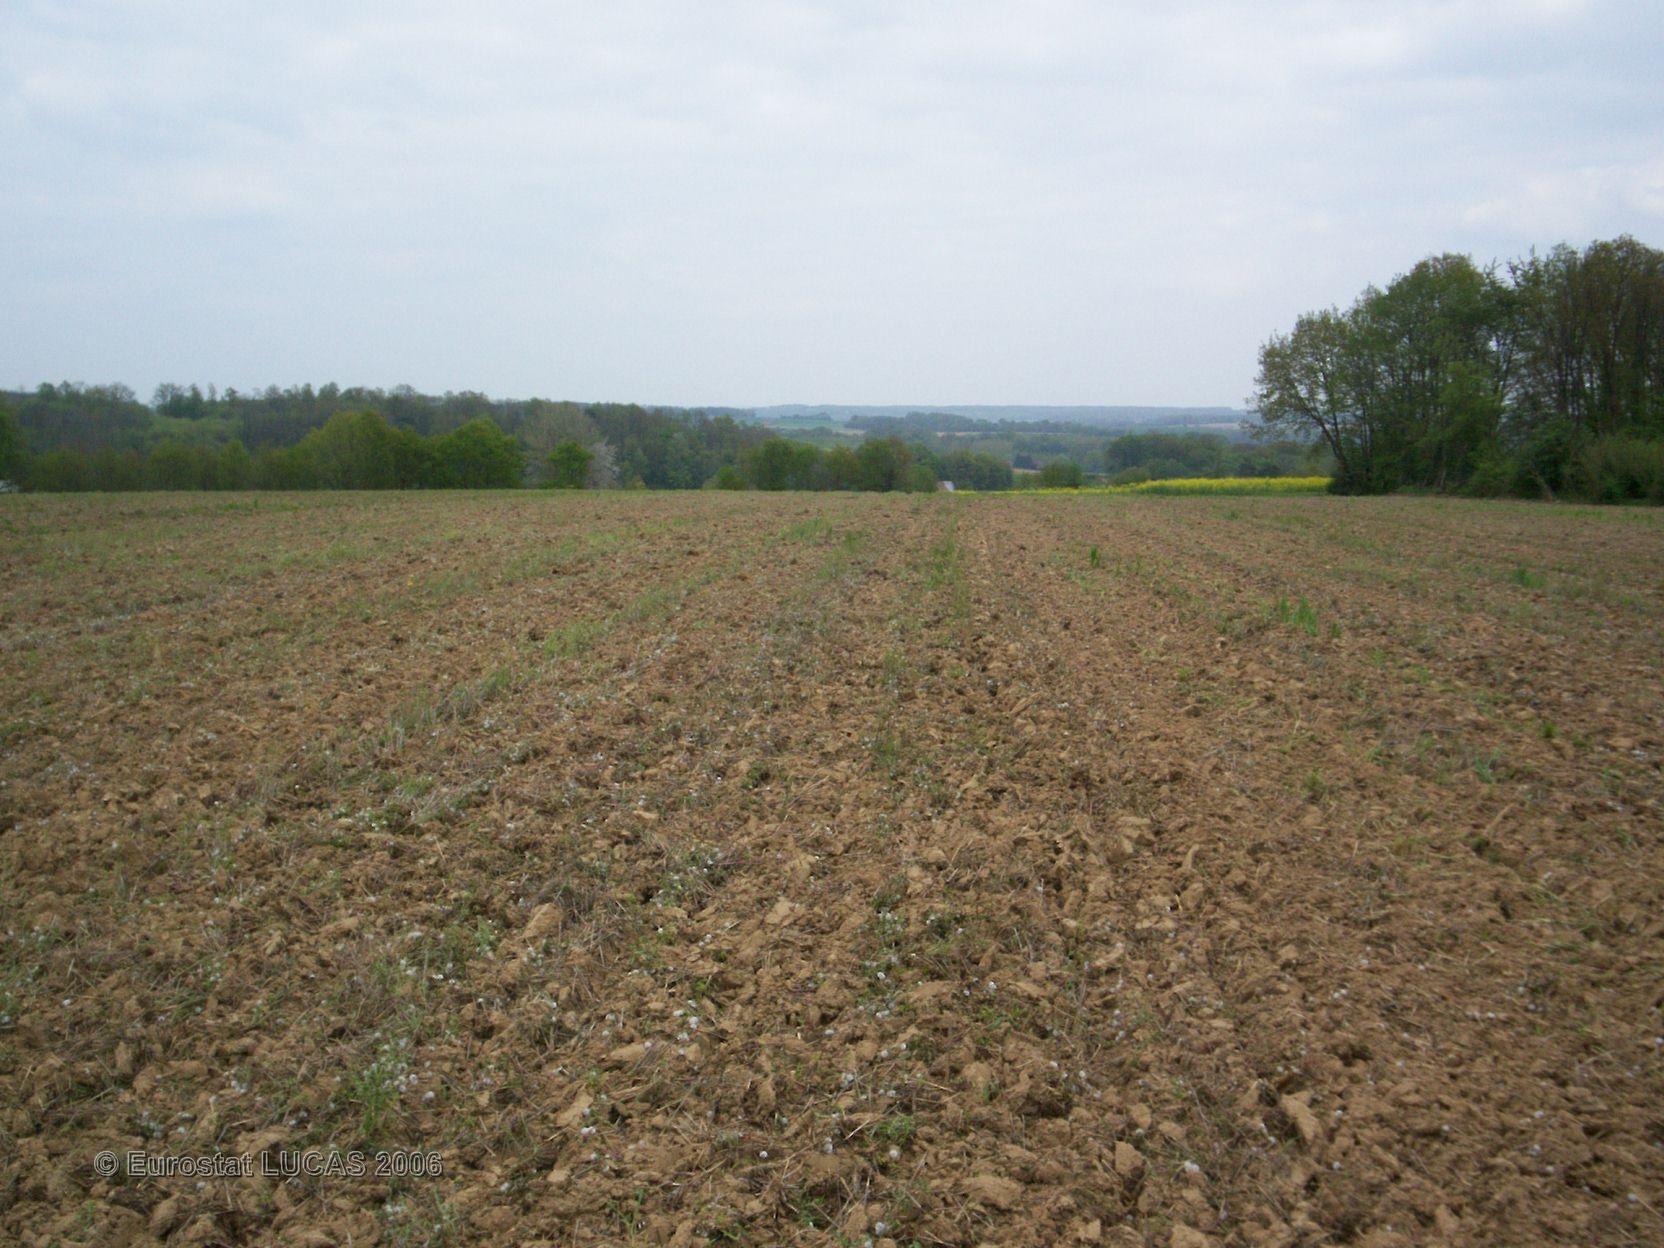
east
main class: Cropland
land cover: Maize
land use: Agriculture (excluding fallow land and kitchen gardens)
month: May
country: FR
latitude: 47.7221
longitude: 0.0955
